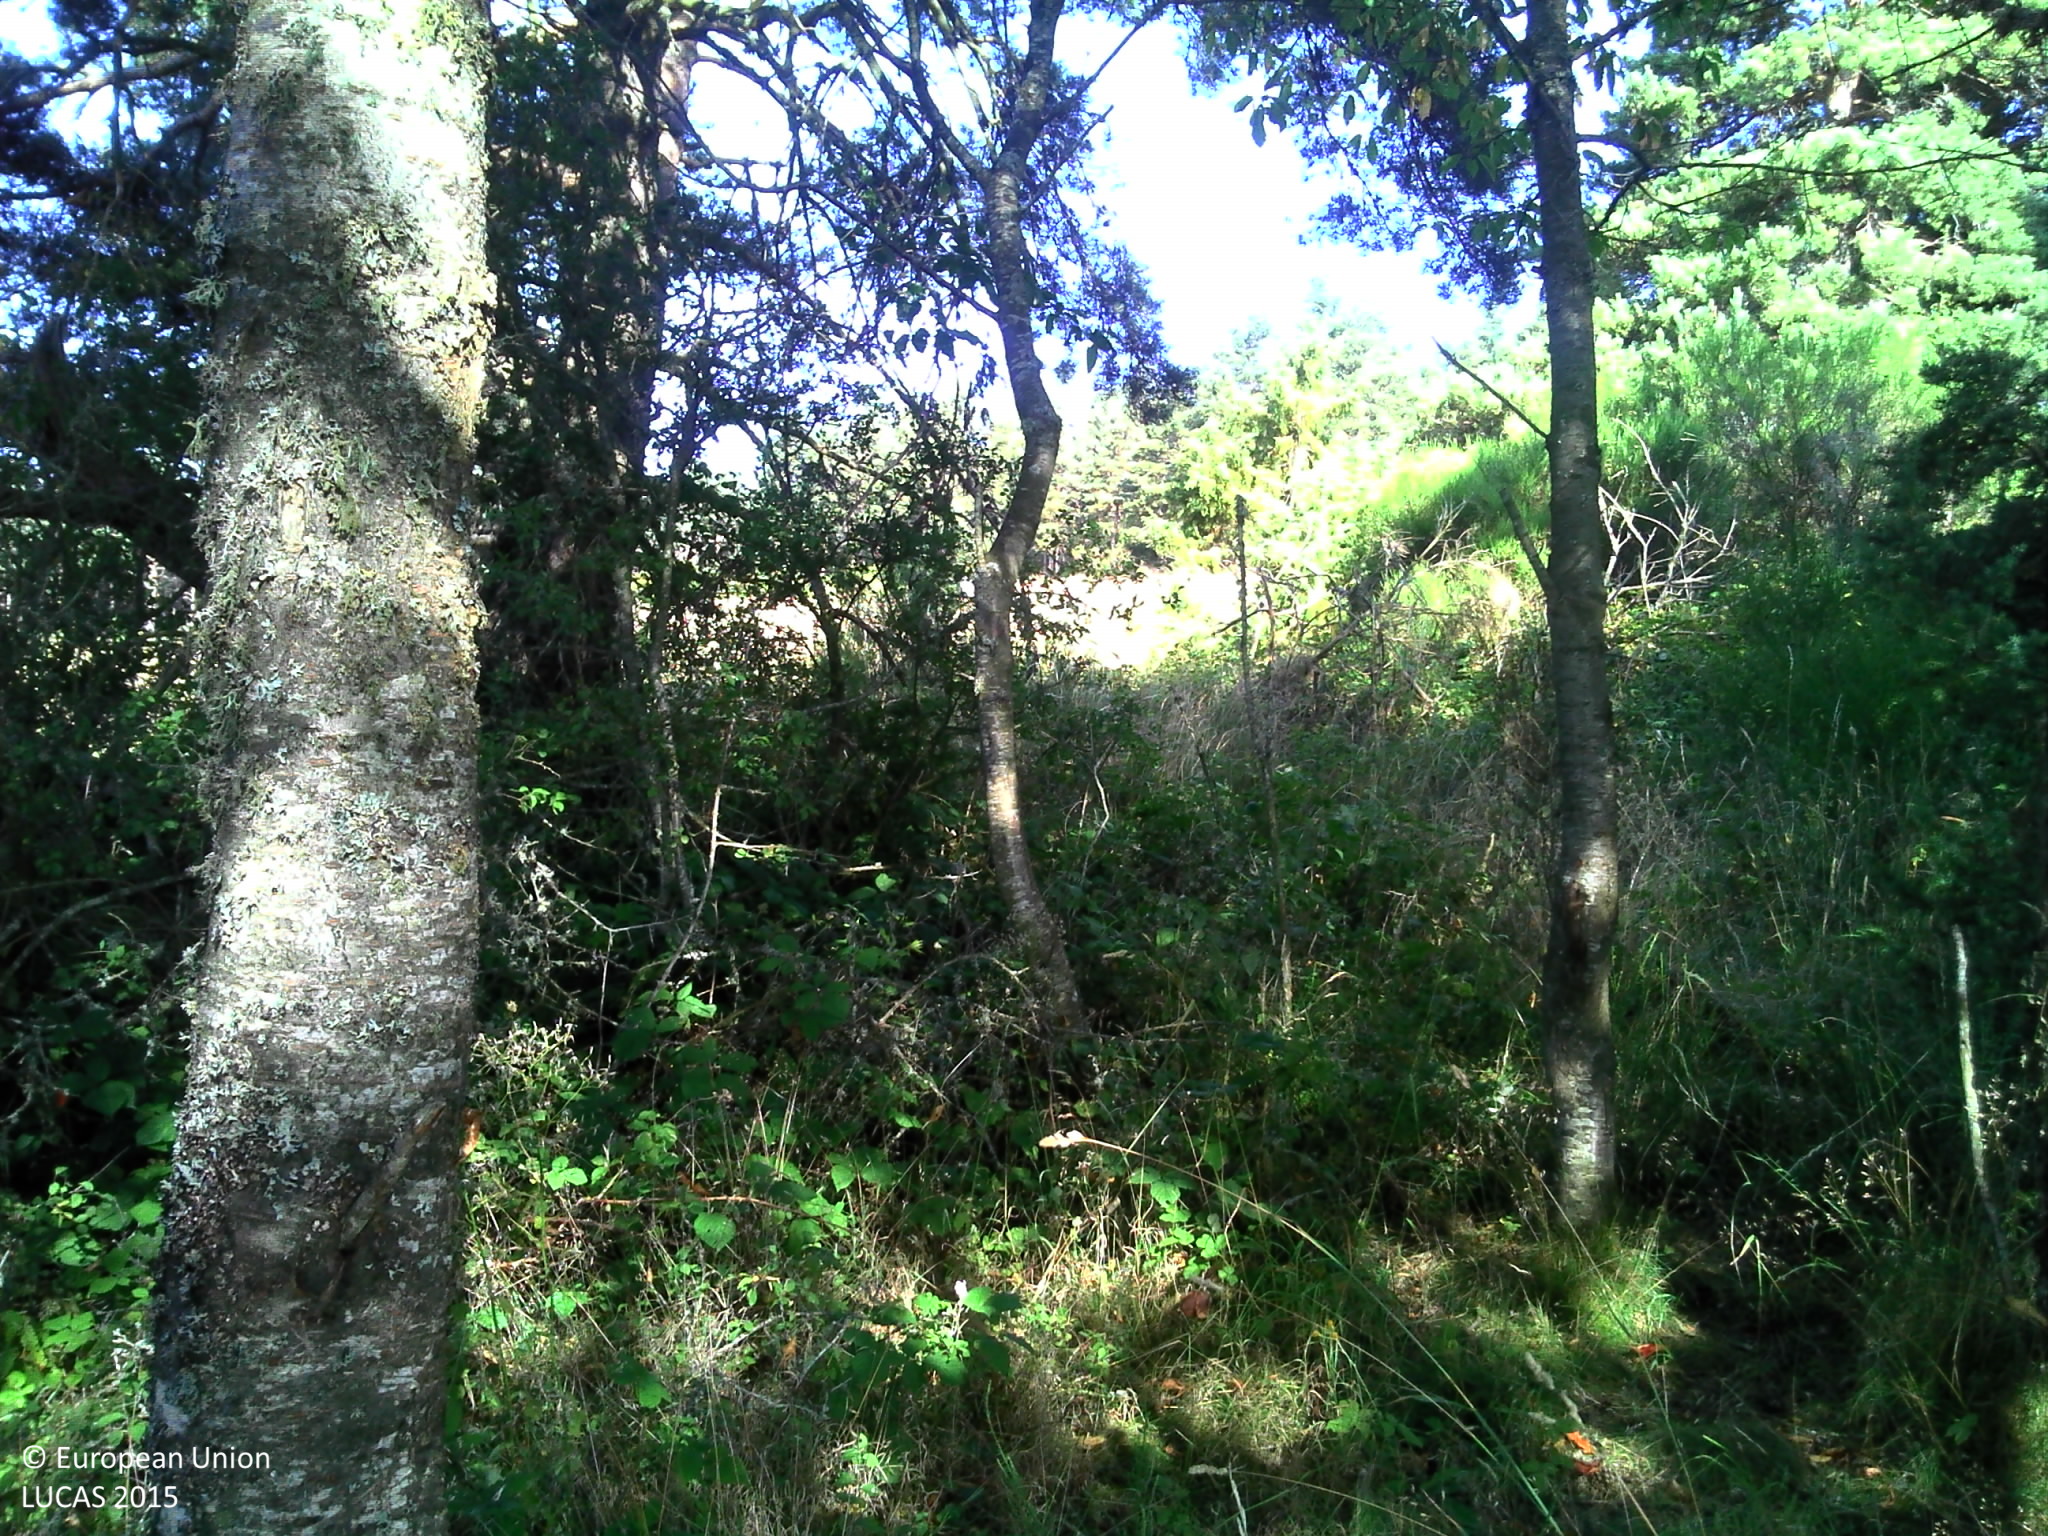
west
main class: Woodland
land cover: Pine dominated mixed woodland
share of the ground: > 75 %
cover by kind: coniferous forest trees 75 %, broadleaved forest trees 25 %
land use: Semi-natural and natural areas not in use
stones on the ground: < 10 %
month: July
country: FR
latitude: 45.0276
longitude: 3.4160
